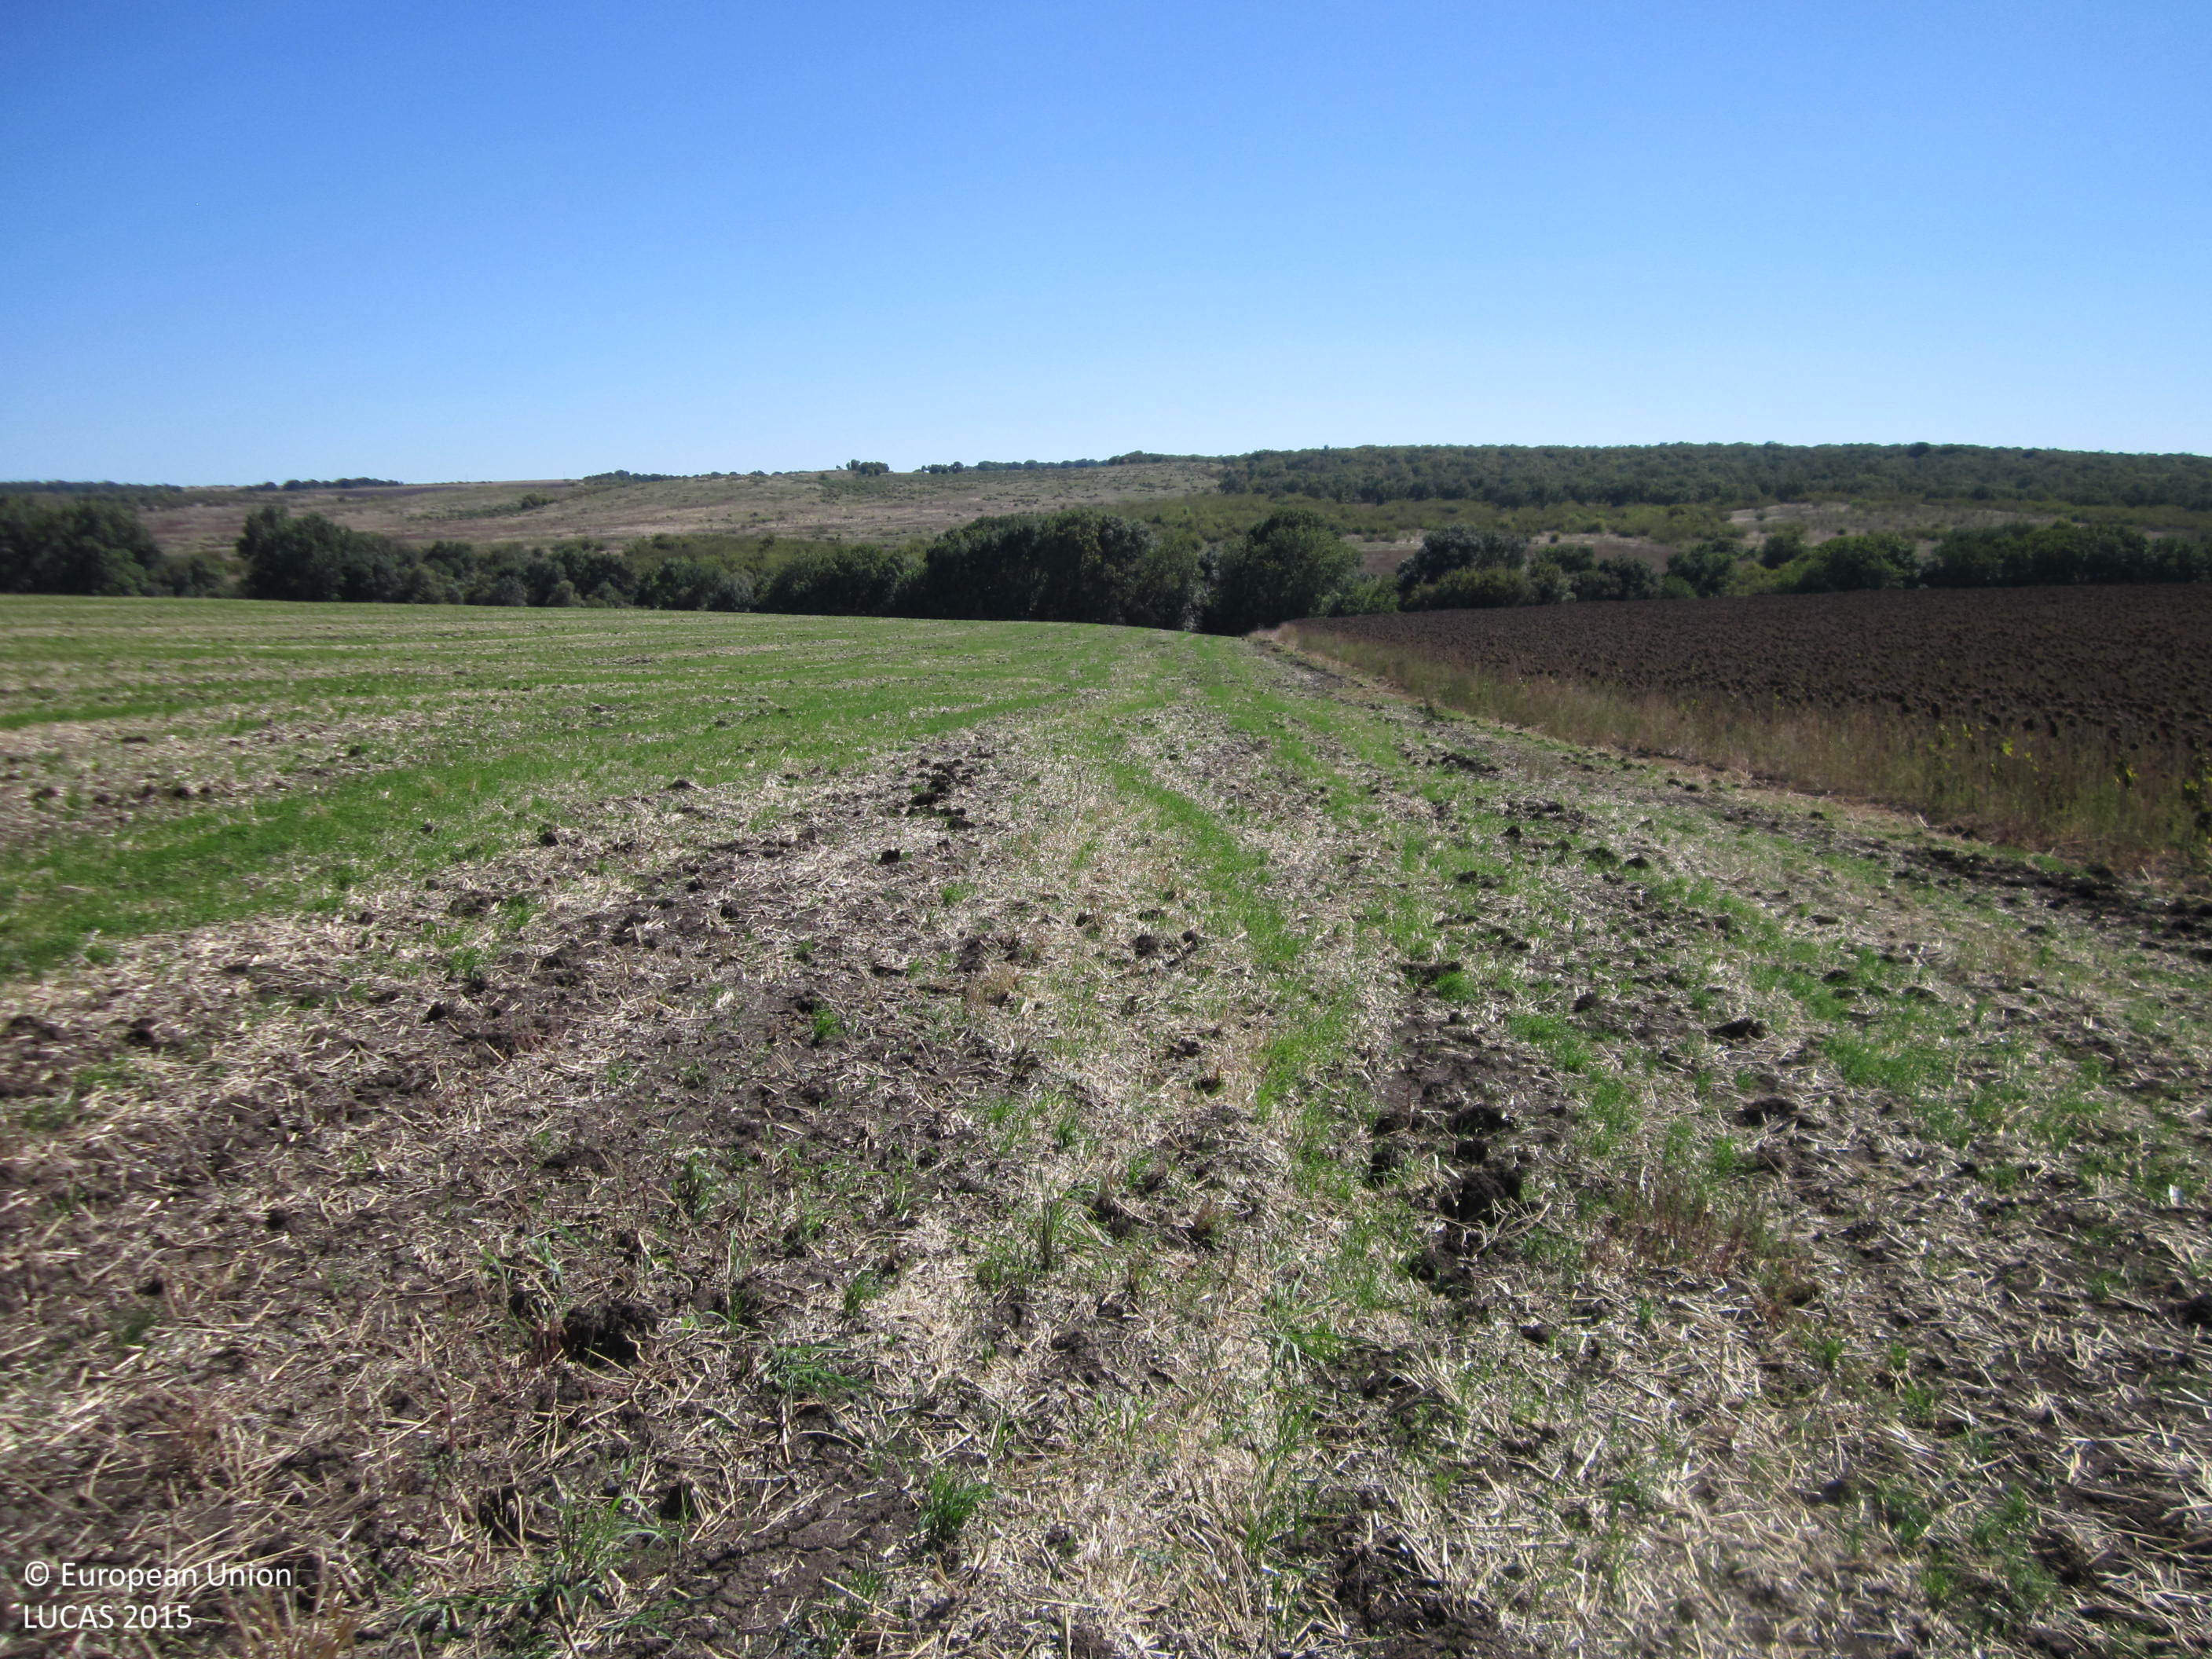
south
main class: Cropland
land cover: Common wheat
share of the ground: 25 - 50 %
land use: Agriculture (excluding fallow land and kitchen gardens)
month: September
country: BG
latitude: 42.4886
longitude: 27.0285
